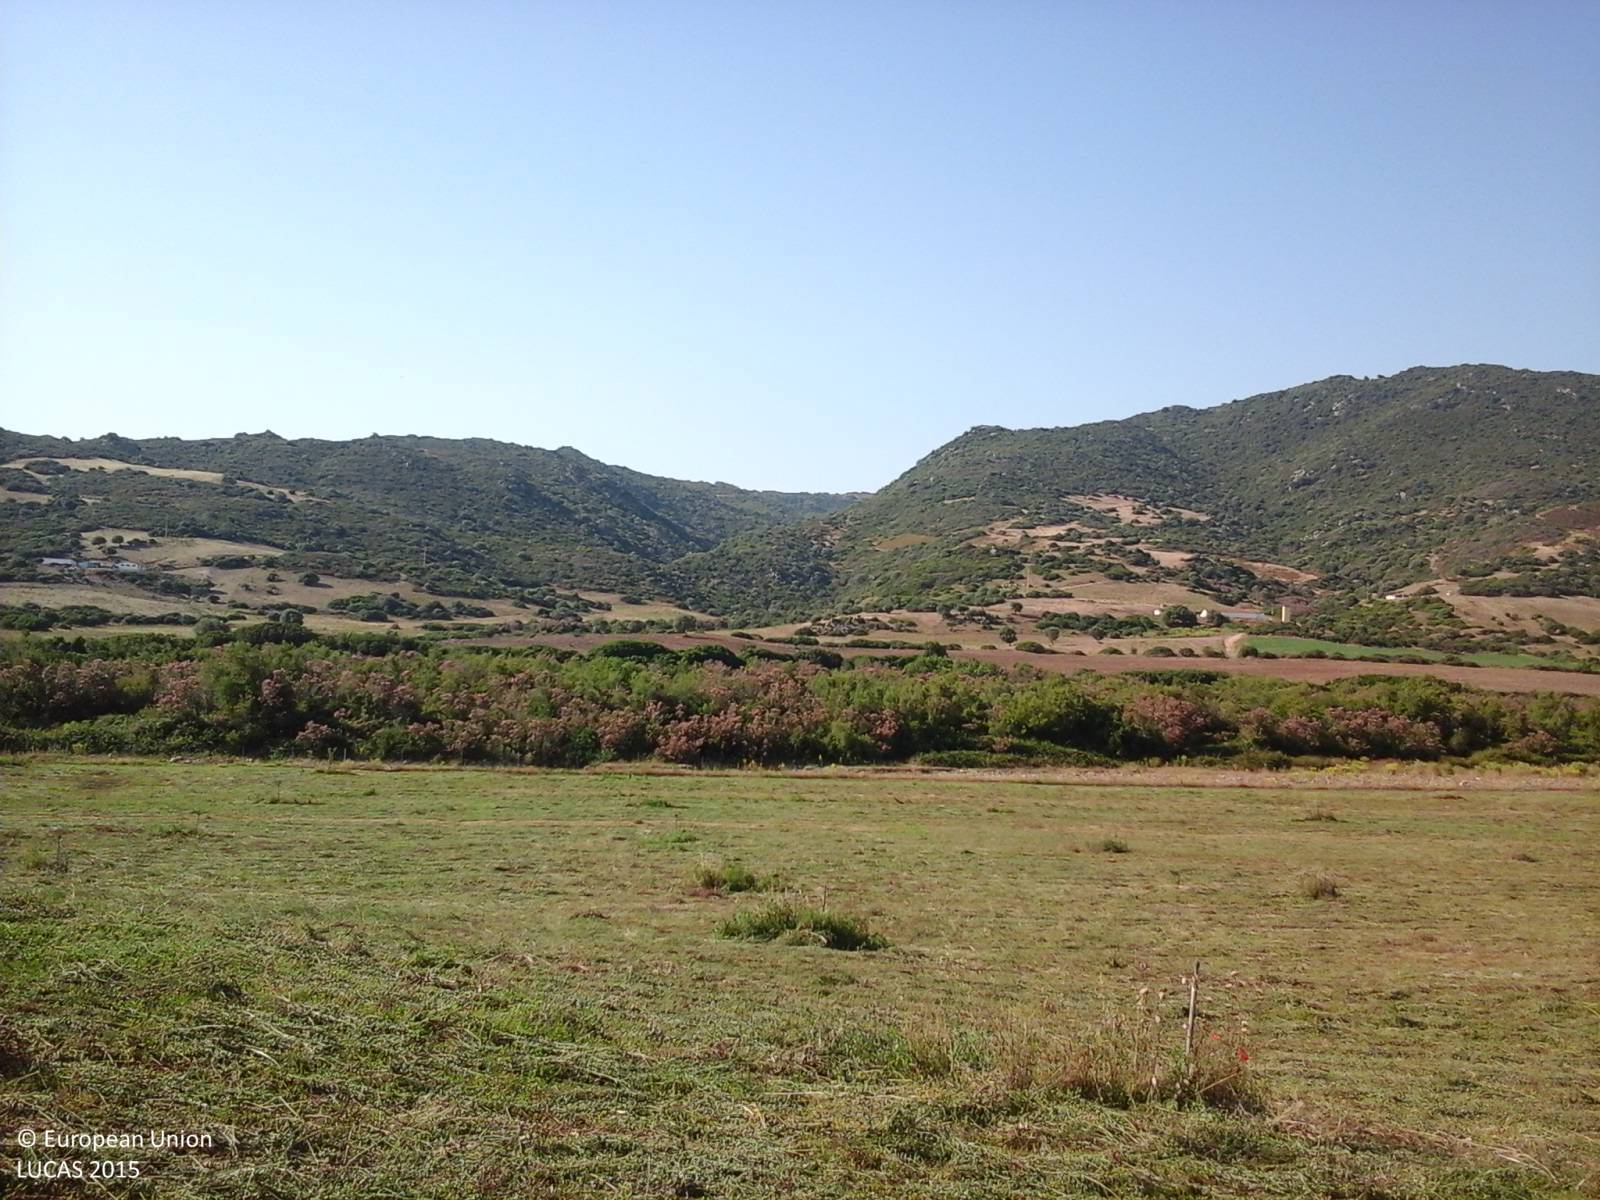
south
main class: Cropland
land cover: Temporary grasslands
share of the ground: > 75 %
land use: Agriculture (excluding fallow land and kitchen gardens)
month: June
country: IT
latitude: 40.3926
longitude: 9.4726
